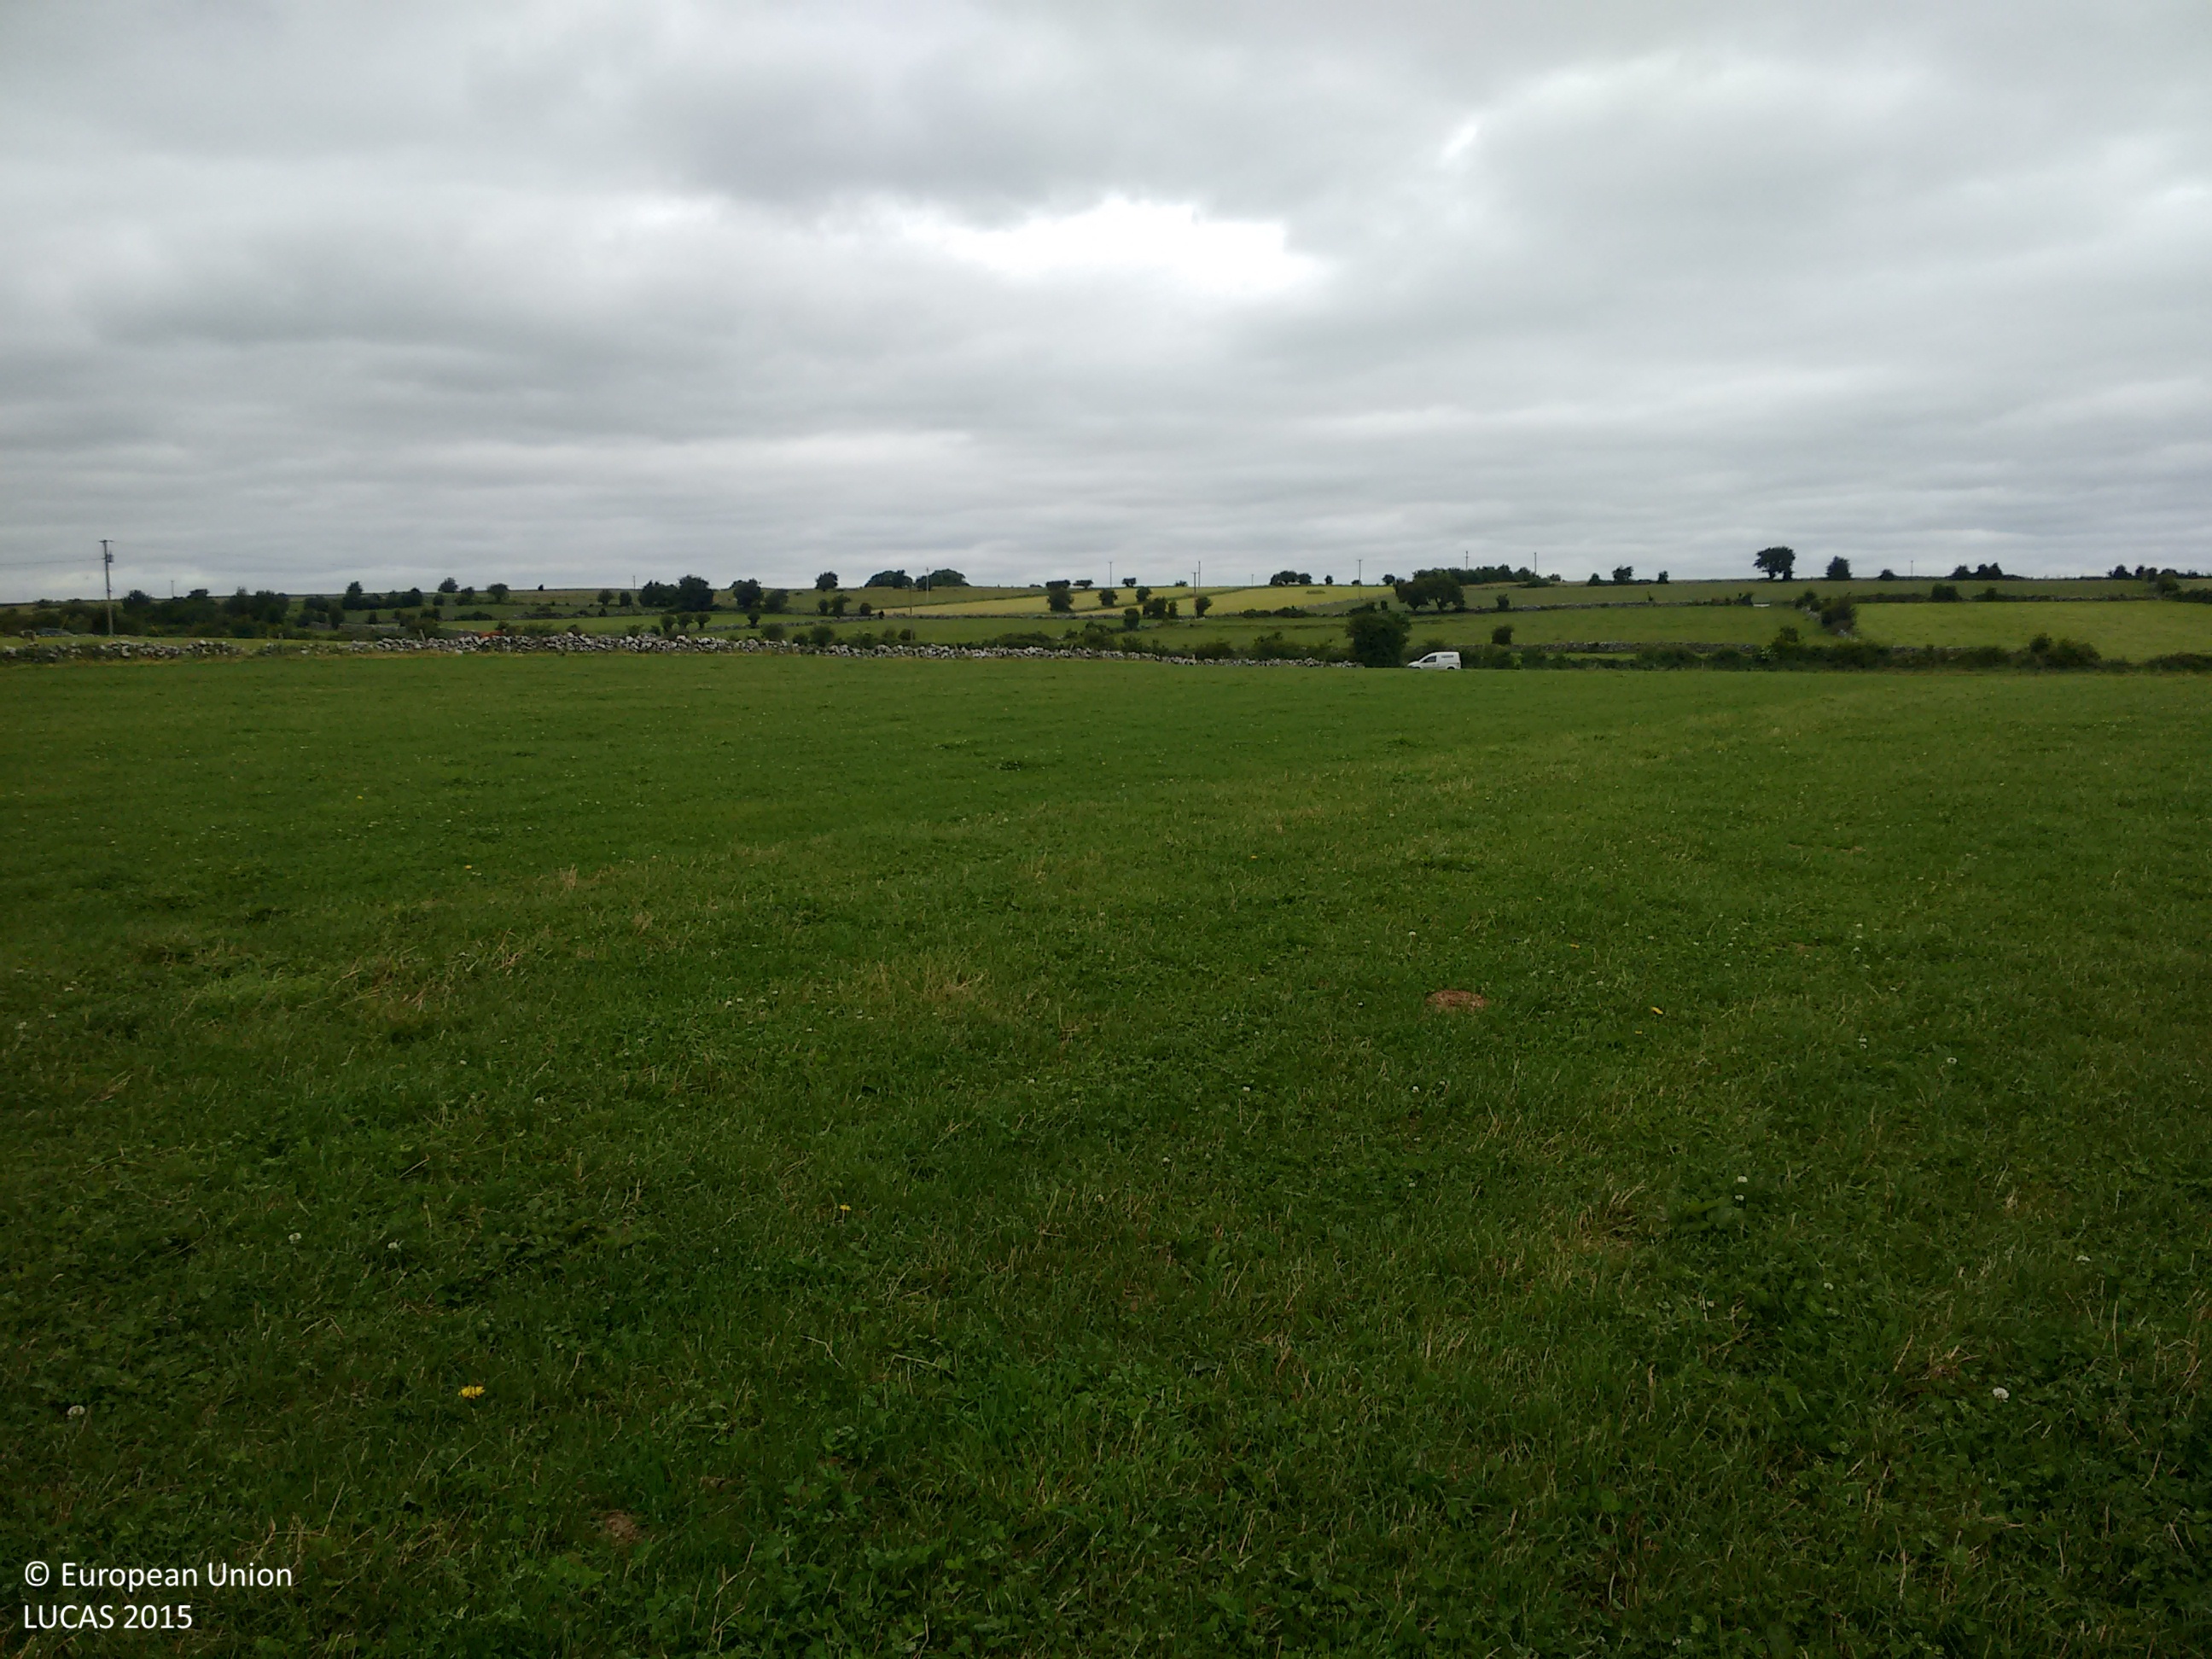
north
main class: Grassland
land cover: Grassland without tree/shrub cover
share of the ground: > 75 %
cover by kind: herbaceous plants 100 %
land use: Agriculture (excluding fallow land and kitchen gardens)
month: July
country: IE
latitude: 53.7096
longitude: -8.1640
